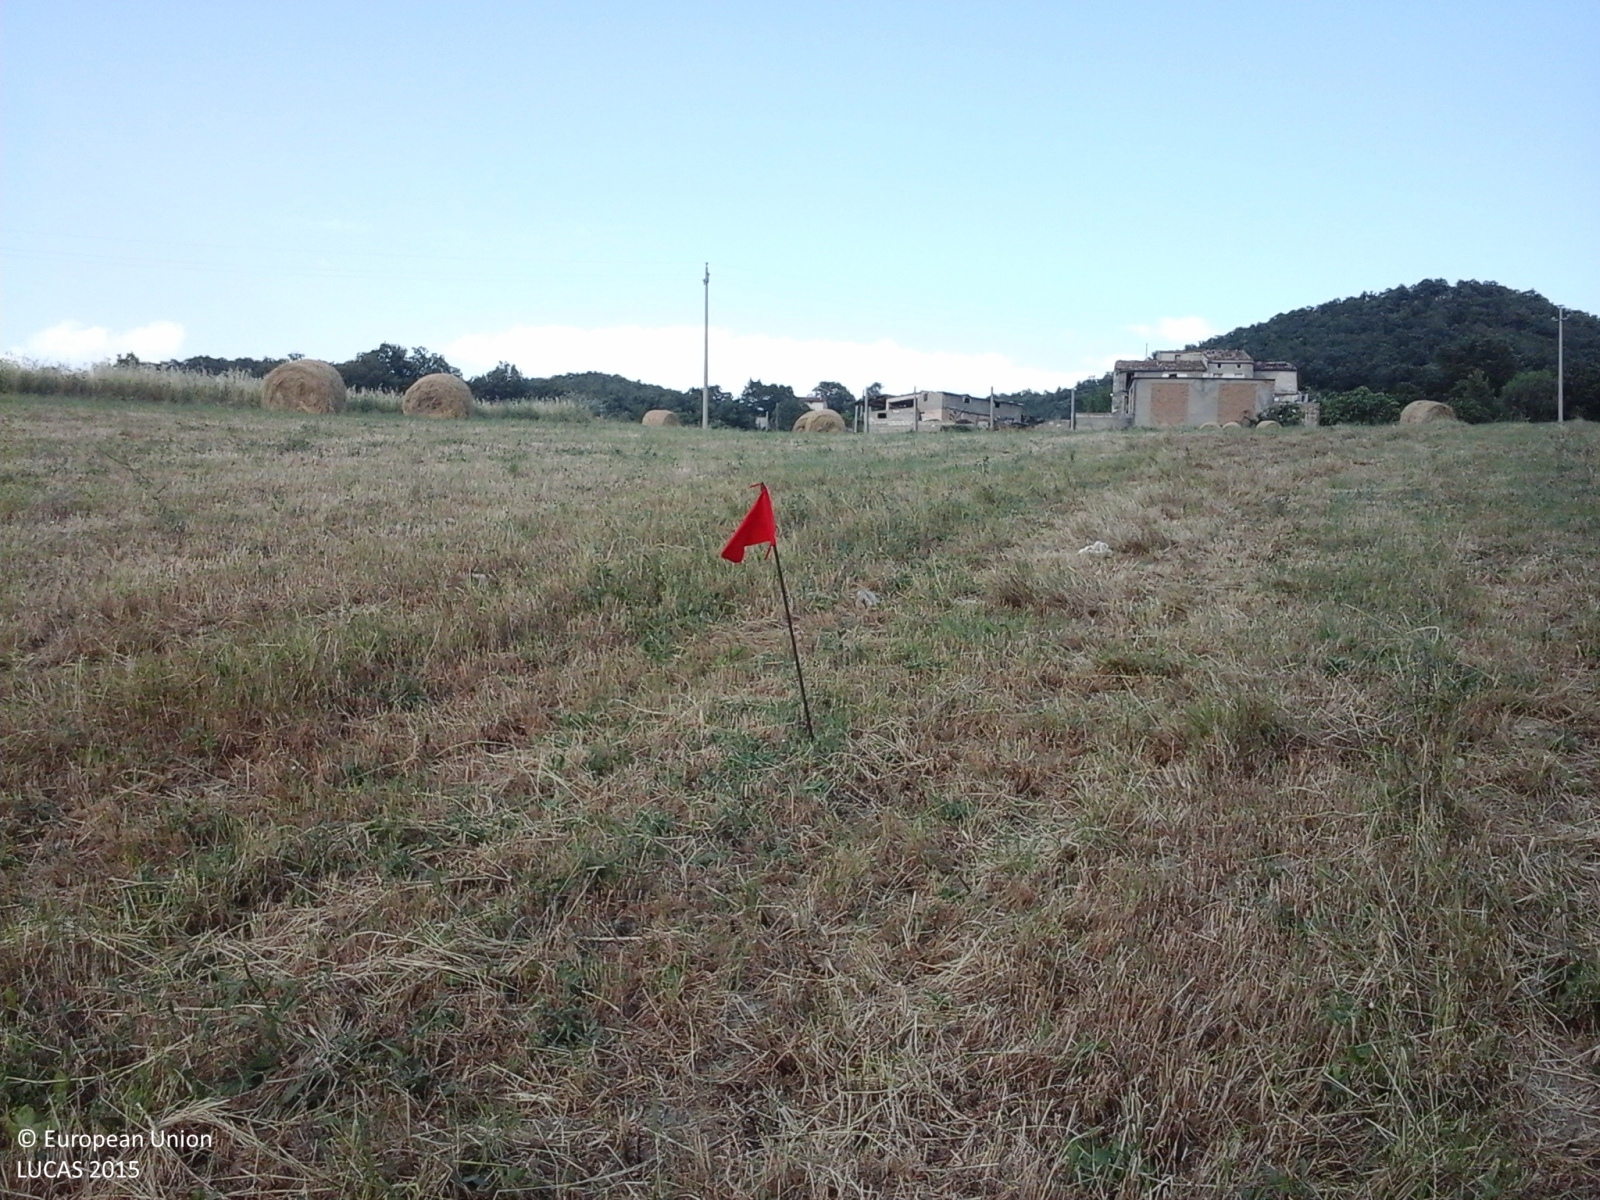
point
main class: Cropland
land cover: Other leguminous and mixtures for fodder
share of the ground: > 75 %
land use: Agriculture (excluding fallow land and kitchen gardens)
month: June
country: IT
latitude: 42.0233
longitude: 14.2253
